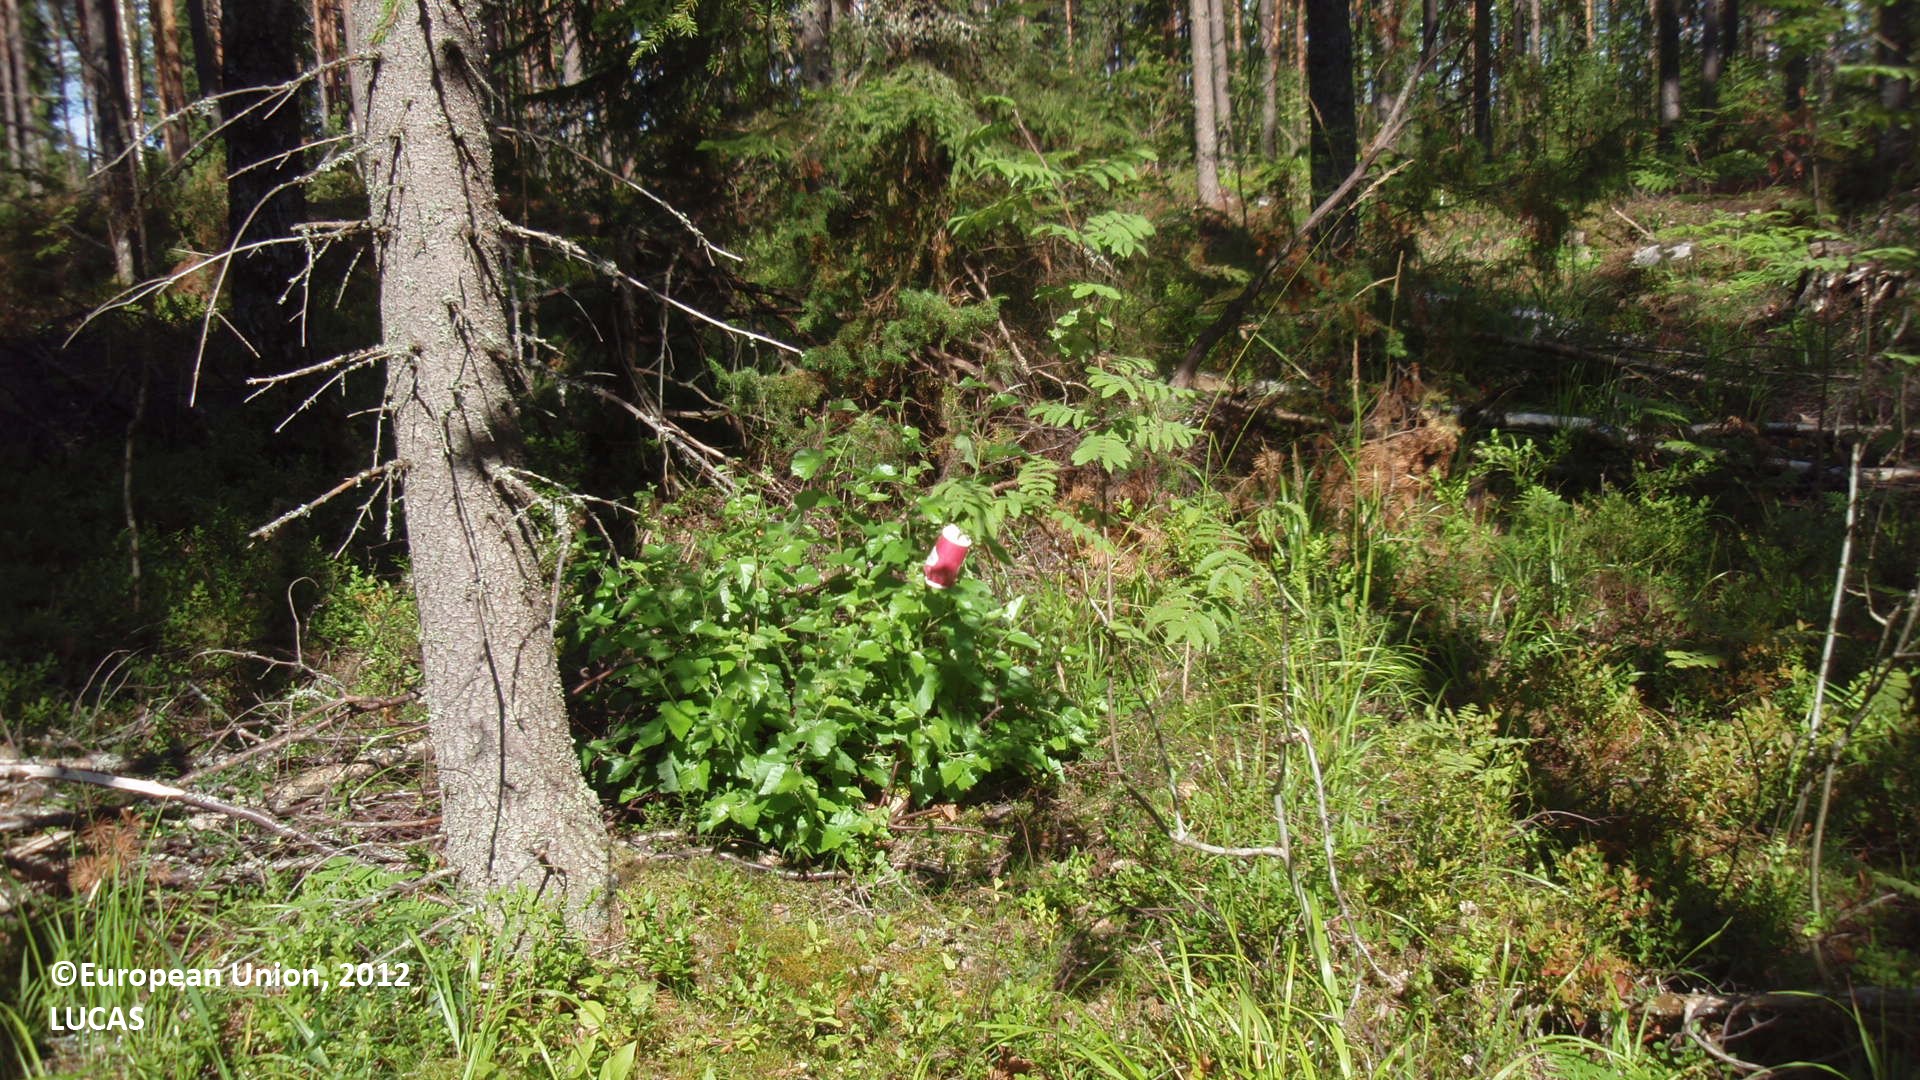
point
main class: Woodland
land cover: Pine dominated coniferous woodland
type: boreal forest
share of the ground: 50 - 75 %
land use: Forestry
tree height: > 5 m
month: August
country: FI
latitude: 61.0831
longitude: 28.0149
